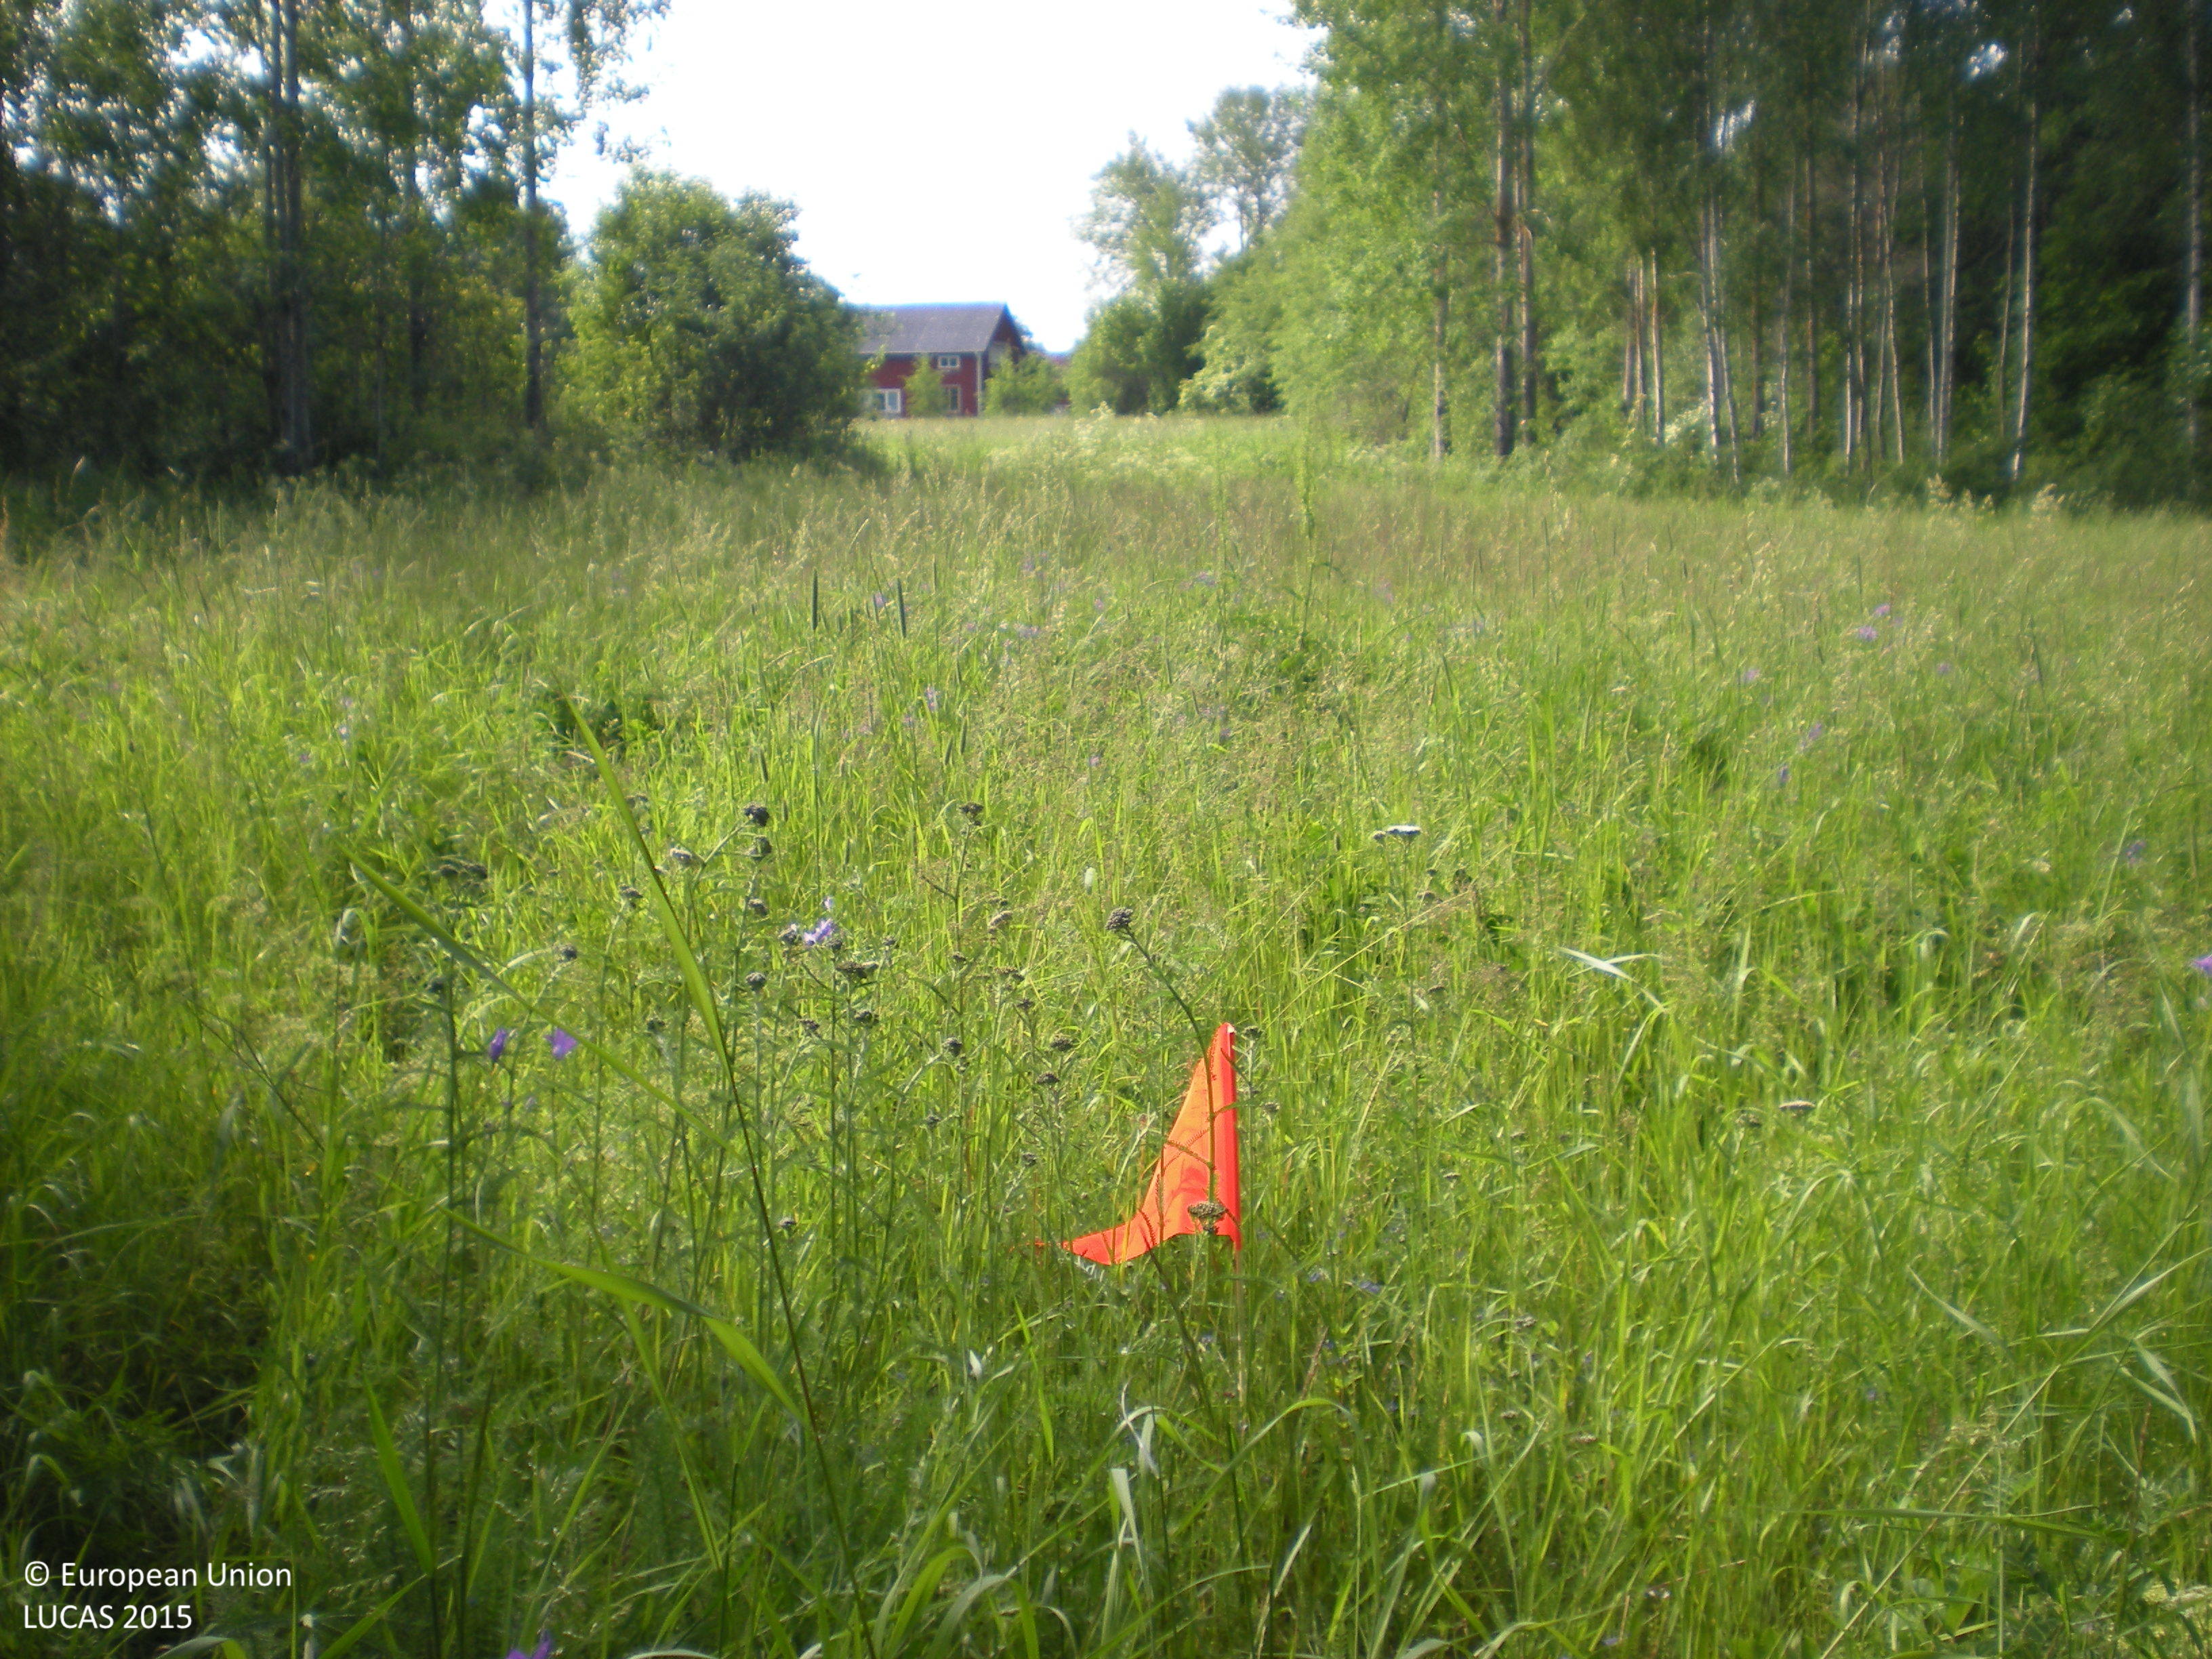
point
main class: Grassland
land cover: Grassland without tree/shrub cover
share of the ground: > 75 %
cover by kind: herbaceous plants 100 %
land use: Agriculture (excluding fallow land and kitchen gardens)
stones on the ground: 10 - 25 %
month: July
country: SE
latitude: 60.5015
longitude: 17.9121
